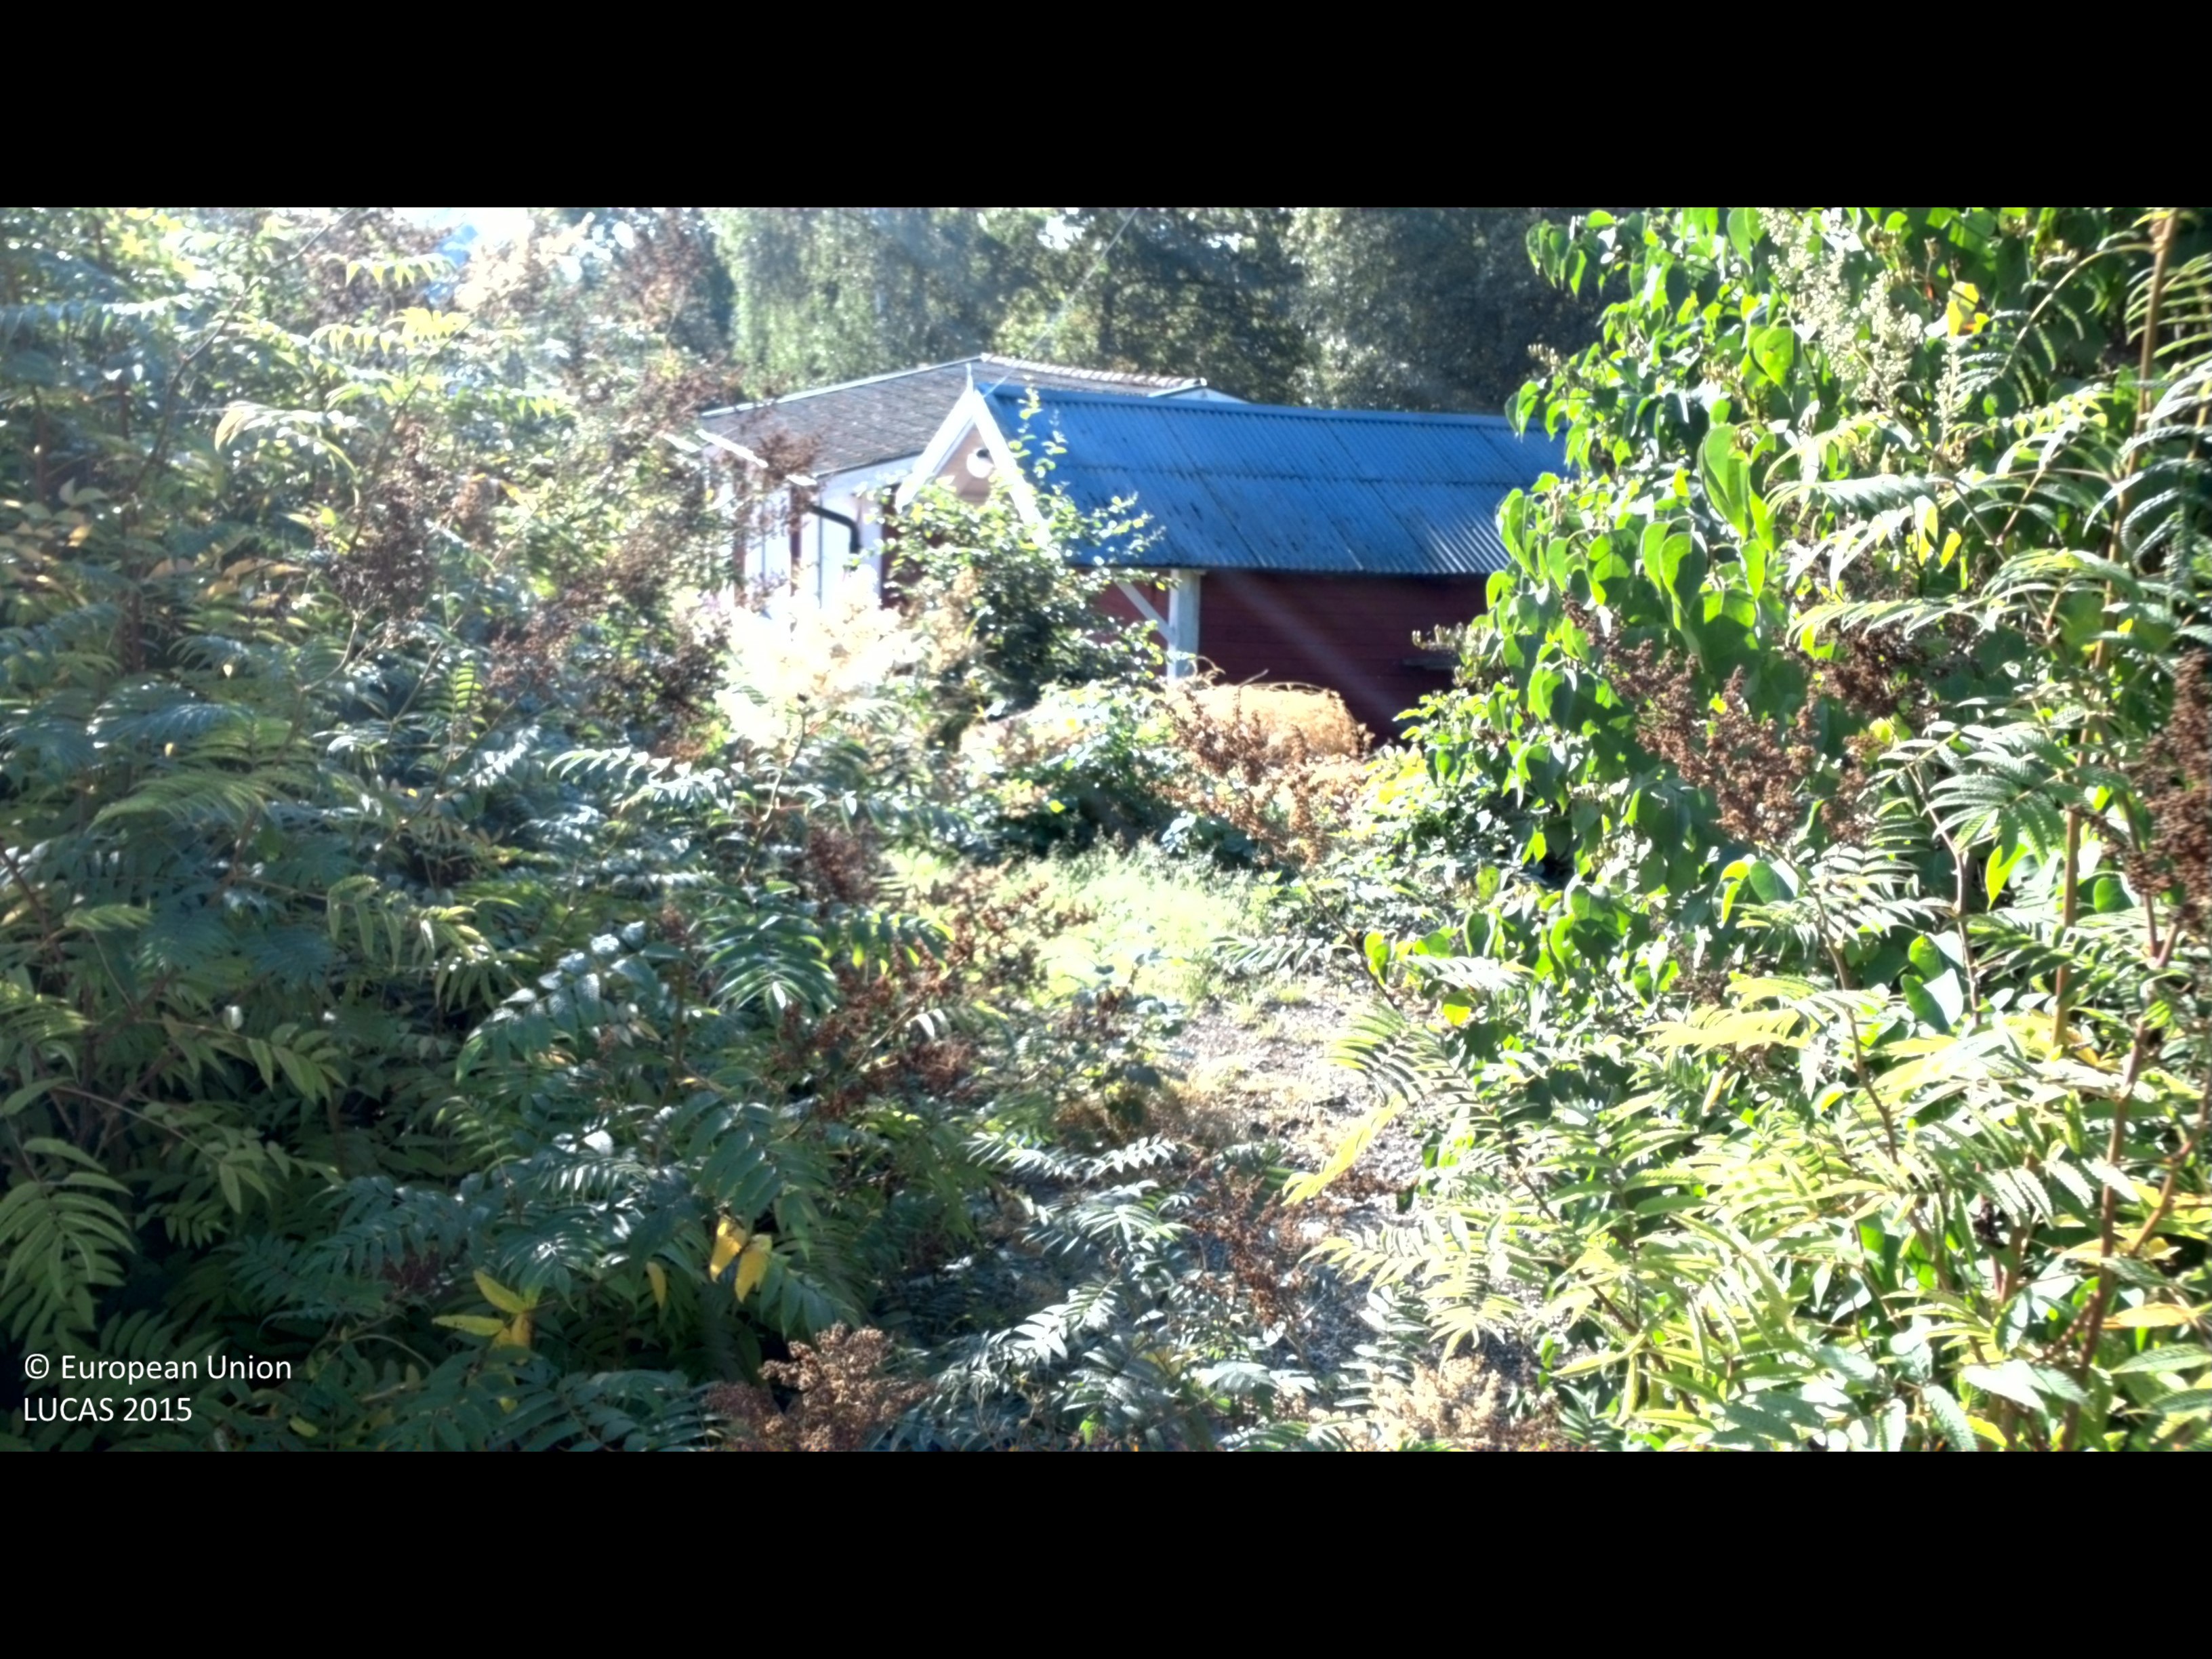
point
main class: Shrubland
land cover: Shrubland with sparse tree cover
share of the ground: > 75 %
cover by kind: shrubs 80 %, herbaceous plants 15 %, broadleaved forest trees 5 %
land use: Residential
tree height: < 5 m
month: August
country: SE
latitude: 56.1981
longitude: 15.0112
